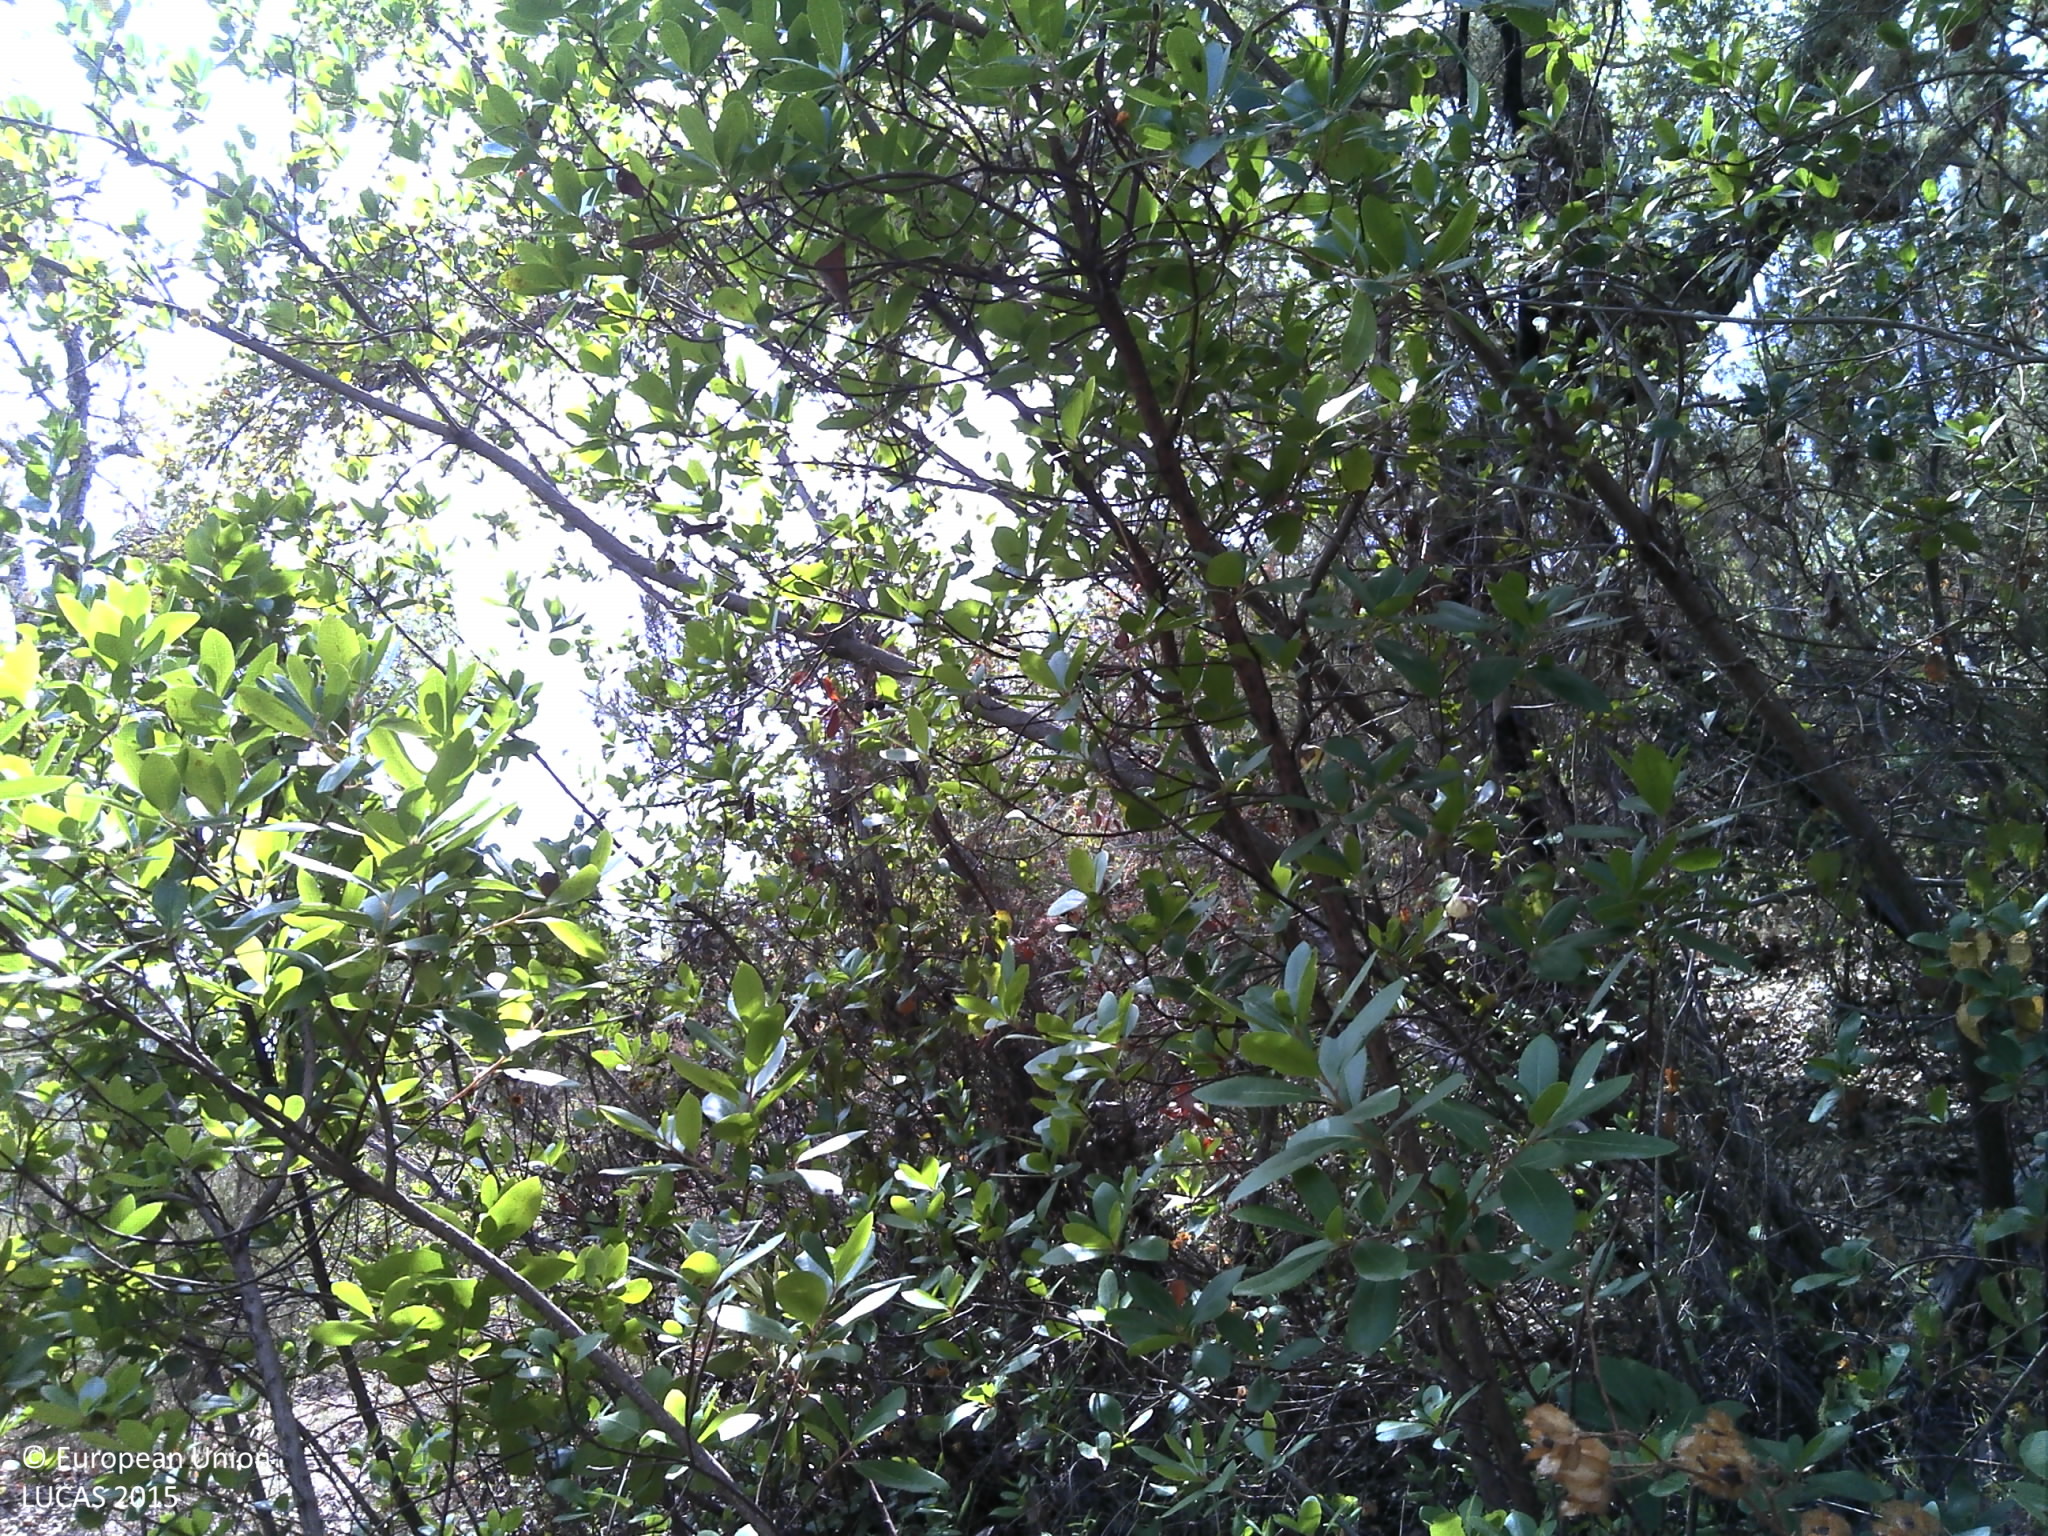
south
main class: Woodland
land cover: Broadleaved woodland
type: broadleaved evergreen forest
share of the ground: 25 - 50 %
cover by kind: shrubs 50 %, broadleaved forest trees 30 %, unconsolidated bare surface 20 %
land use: Forestry
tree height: > 5 m
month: September
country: PT
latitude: 37.3930
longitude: -8.2434
